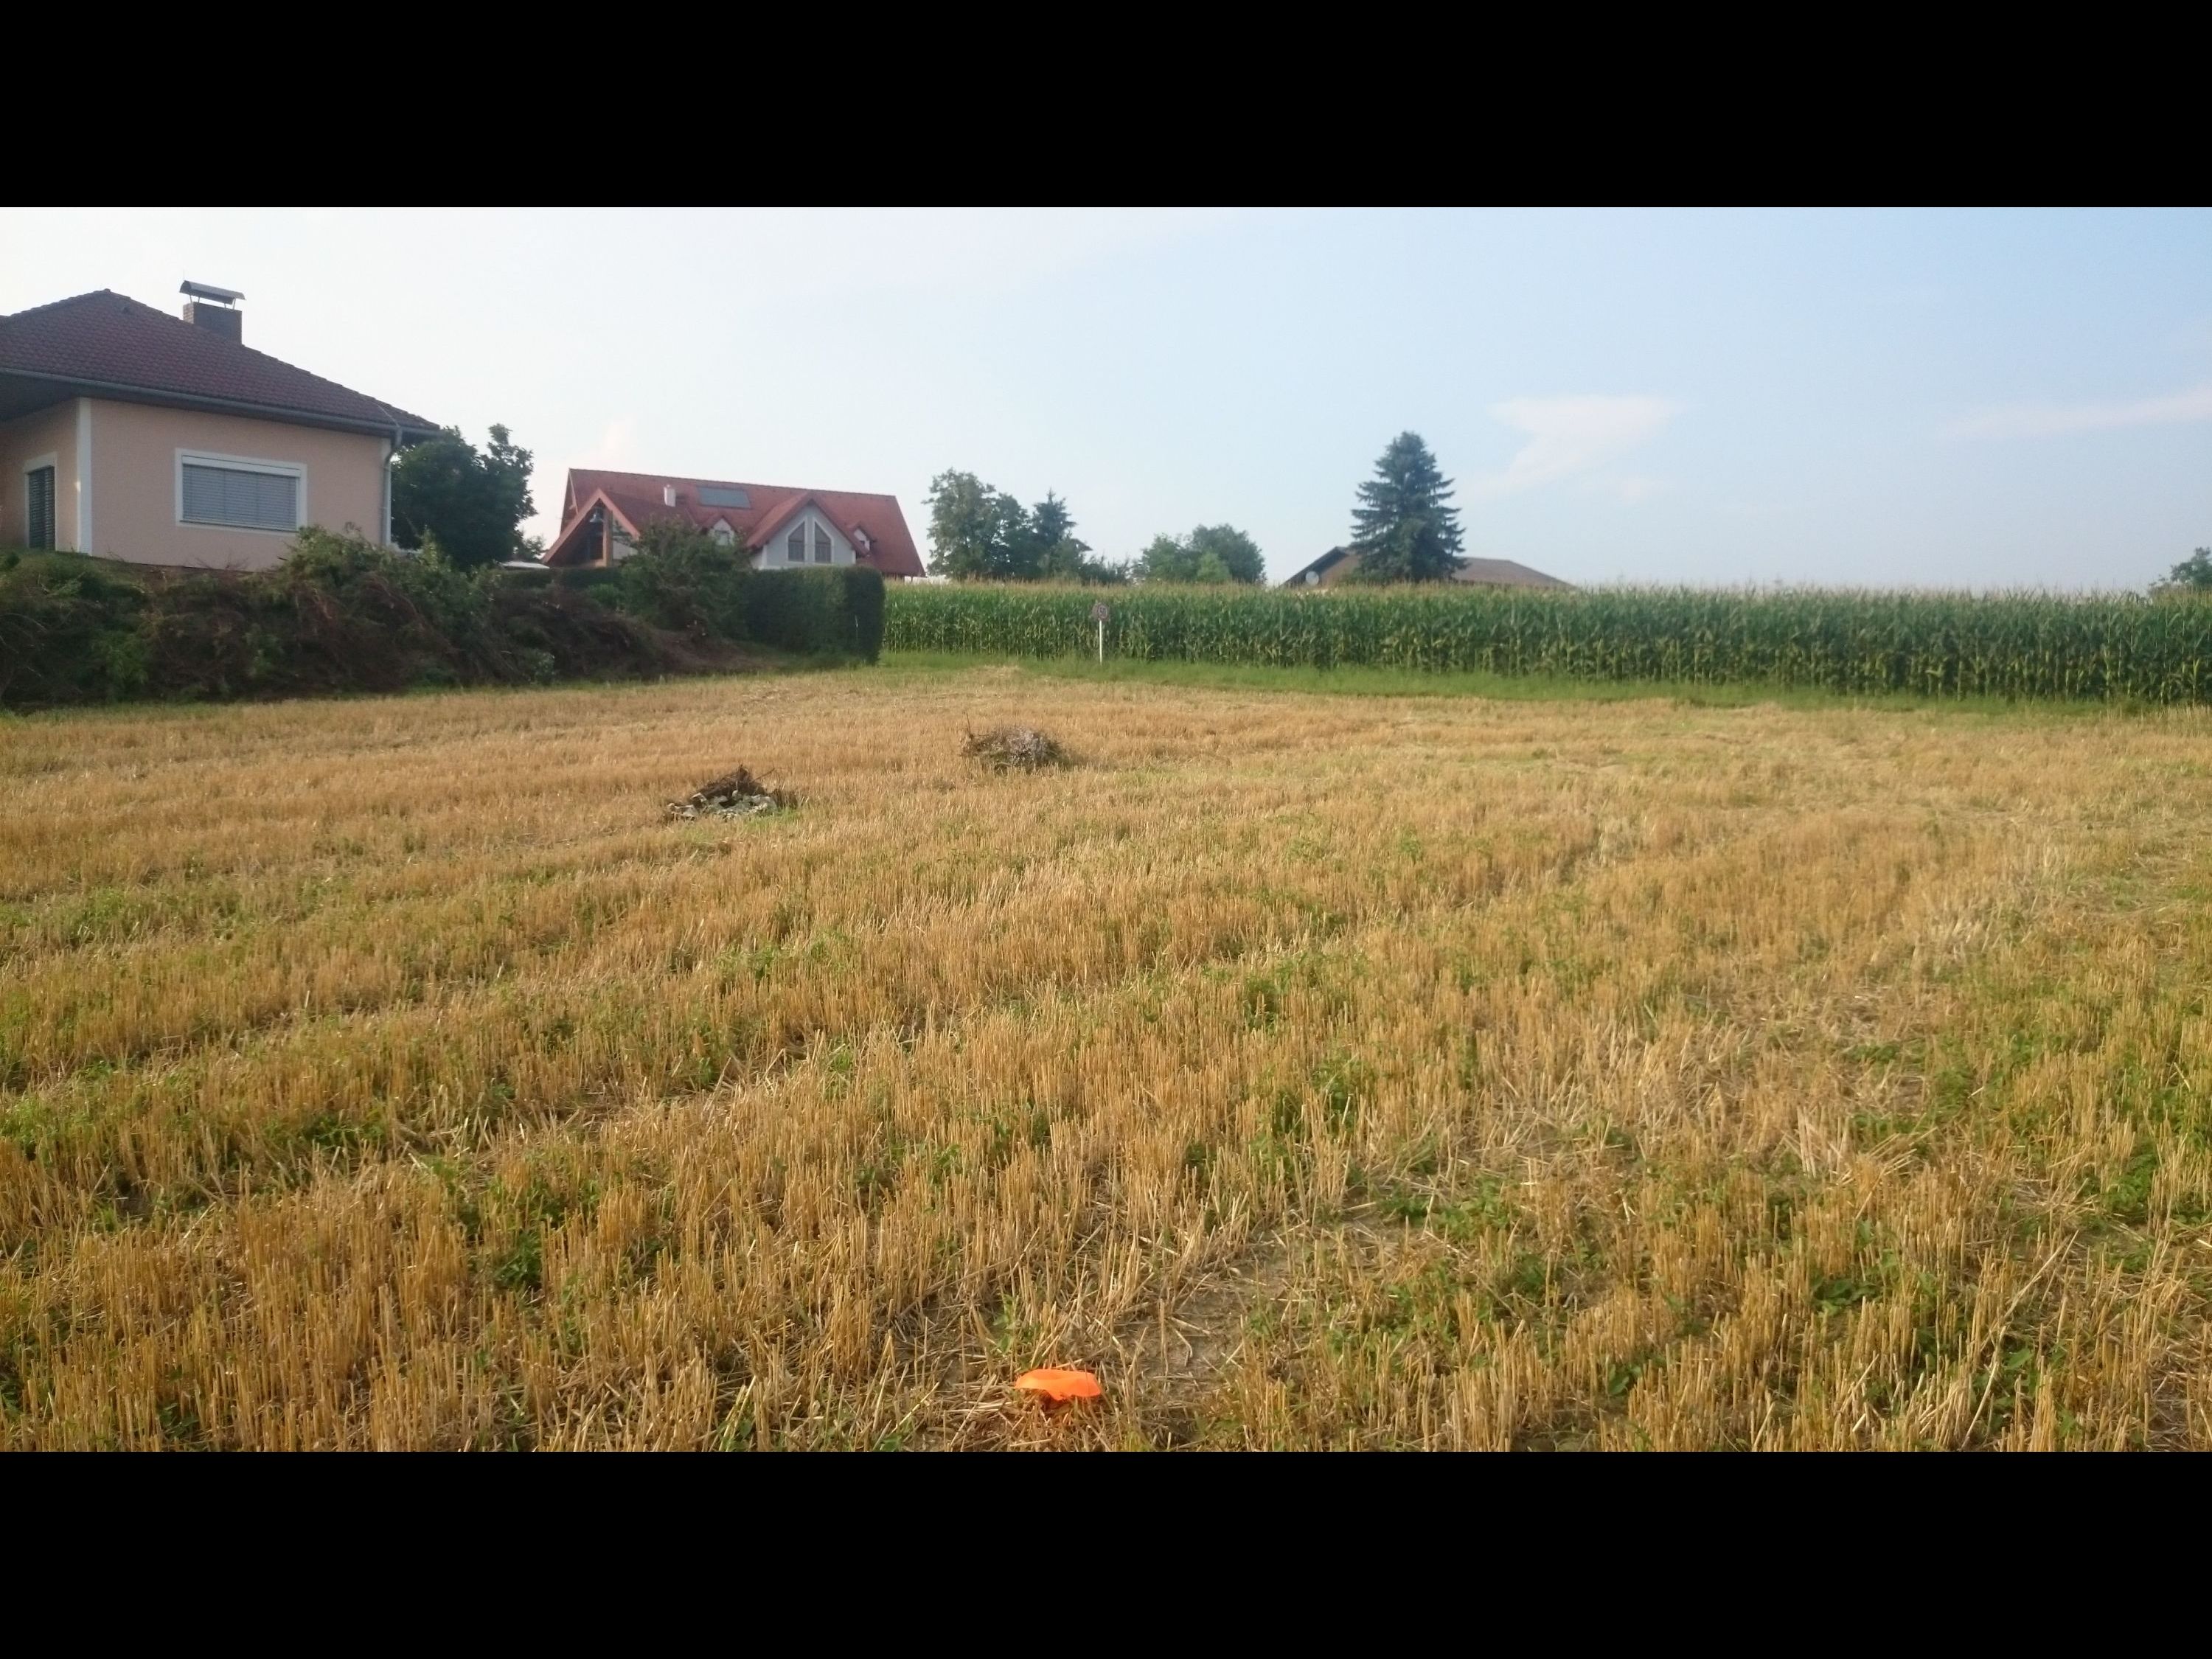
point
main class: Cropland
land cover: Common wheat
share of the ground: > 75 %
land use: Agriculture (excluding fallow land and kitchen gardens)
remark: Harvested field
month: July
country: AT
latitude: 47.0543
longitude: 15.9117
